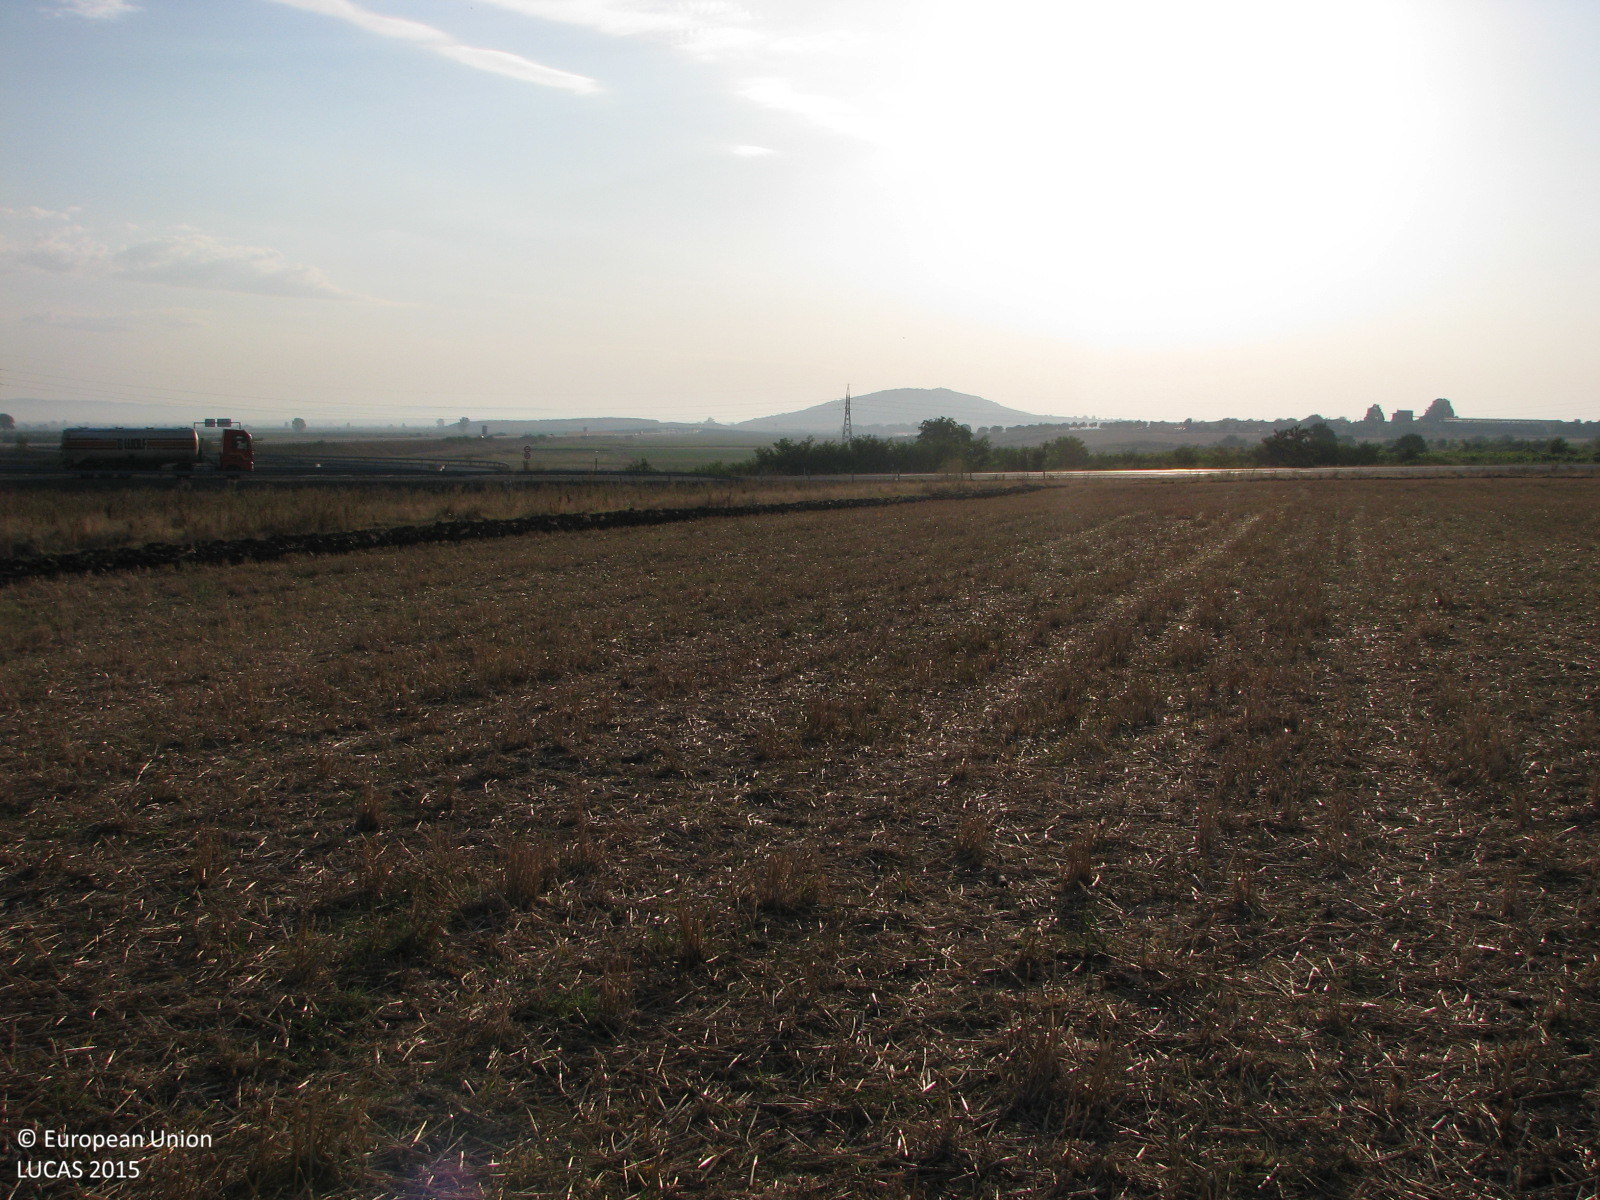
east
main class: Cropland
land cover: Common wheat
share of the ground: < 10 %
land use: Agriculture (excluding fallow land and kitchen gardens)
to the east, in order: Common wheat; Electric lines; Common wheat; Spontaneously vegetated surfaces; Fences; Ditches and canals; Grass margins; Paved roads, cycling and walking lanes; Grass margins; Paved roads, cycling and walking lanes; Grass margins; Ditches and canals; Spontaneously vegetated surfaces; Vineyards
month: August
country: BG
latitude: 42.5357
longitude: 26.4181
